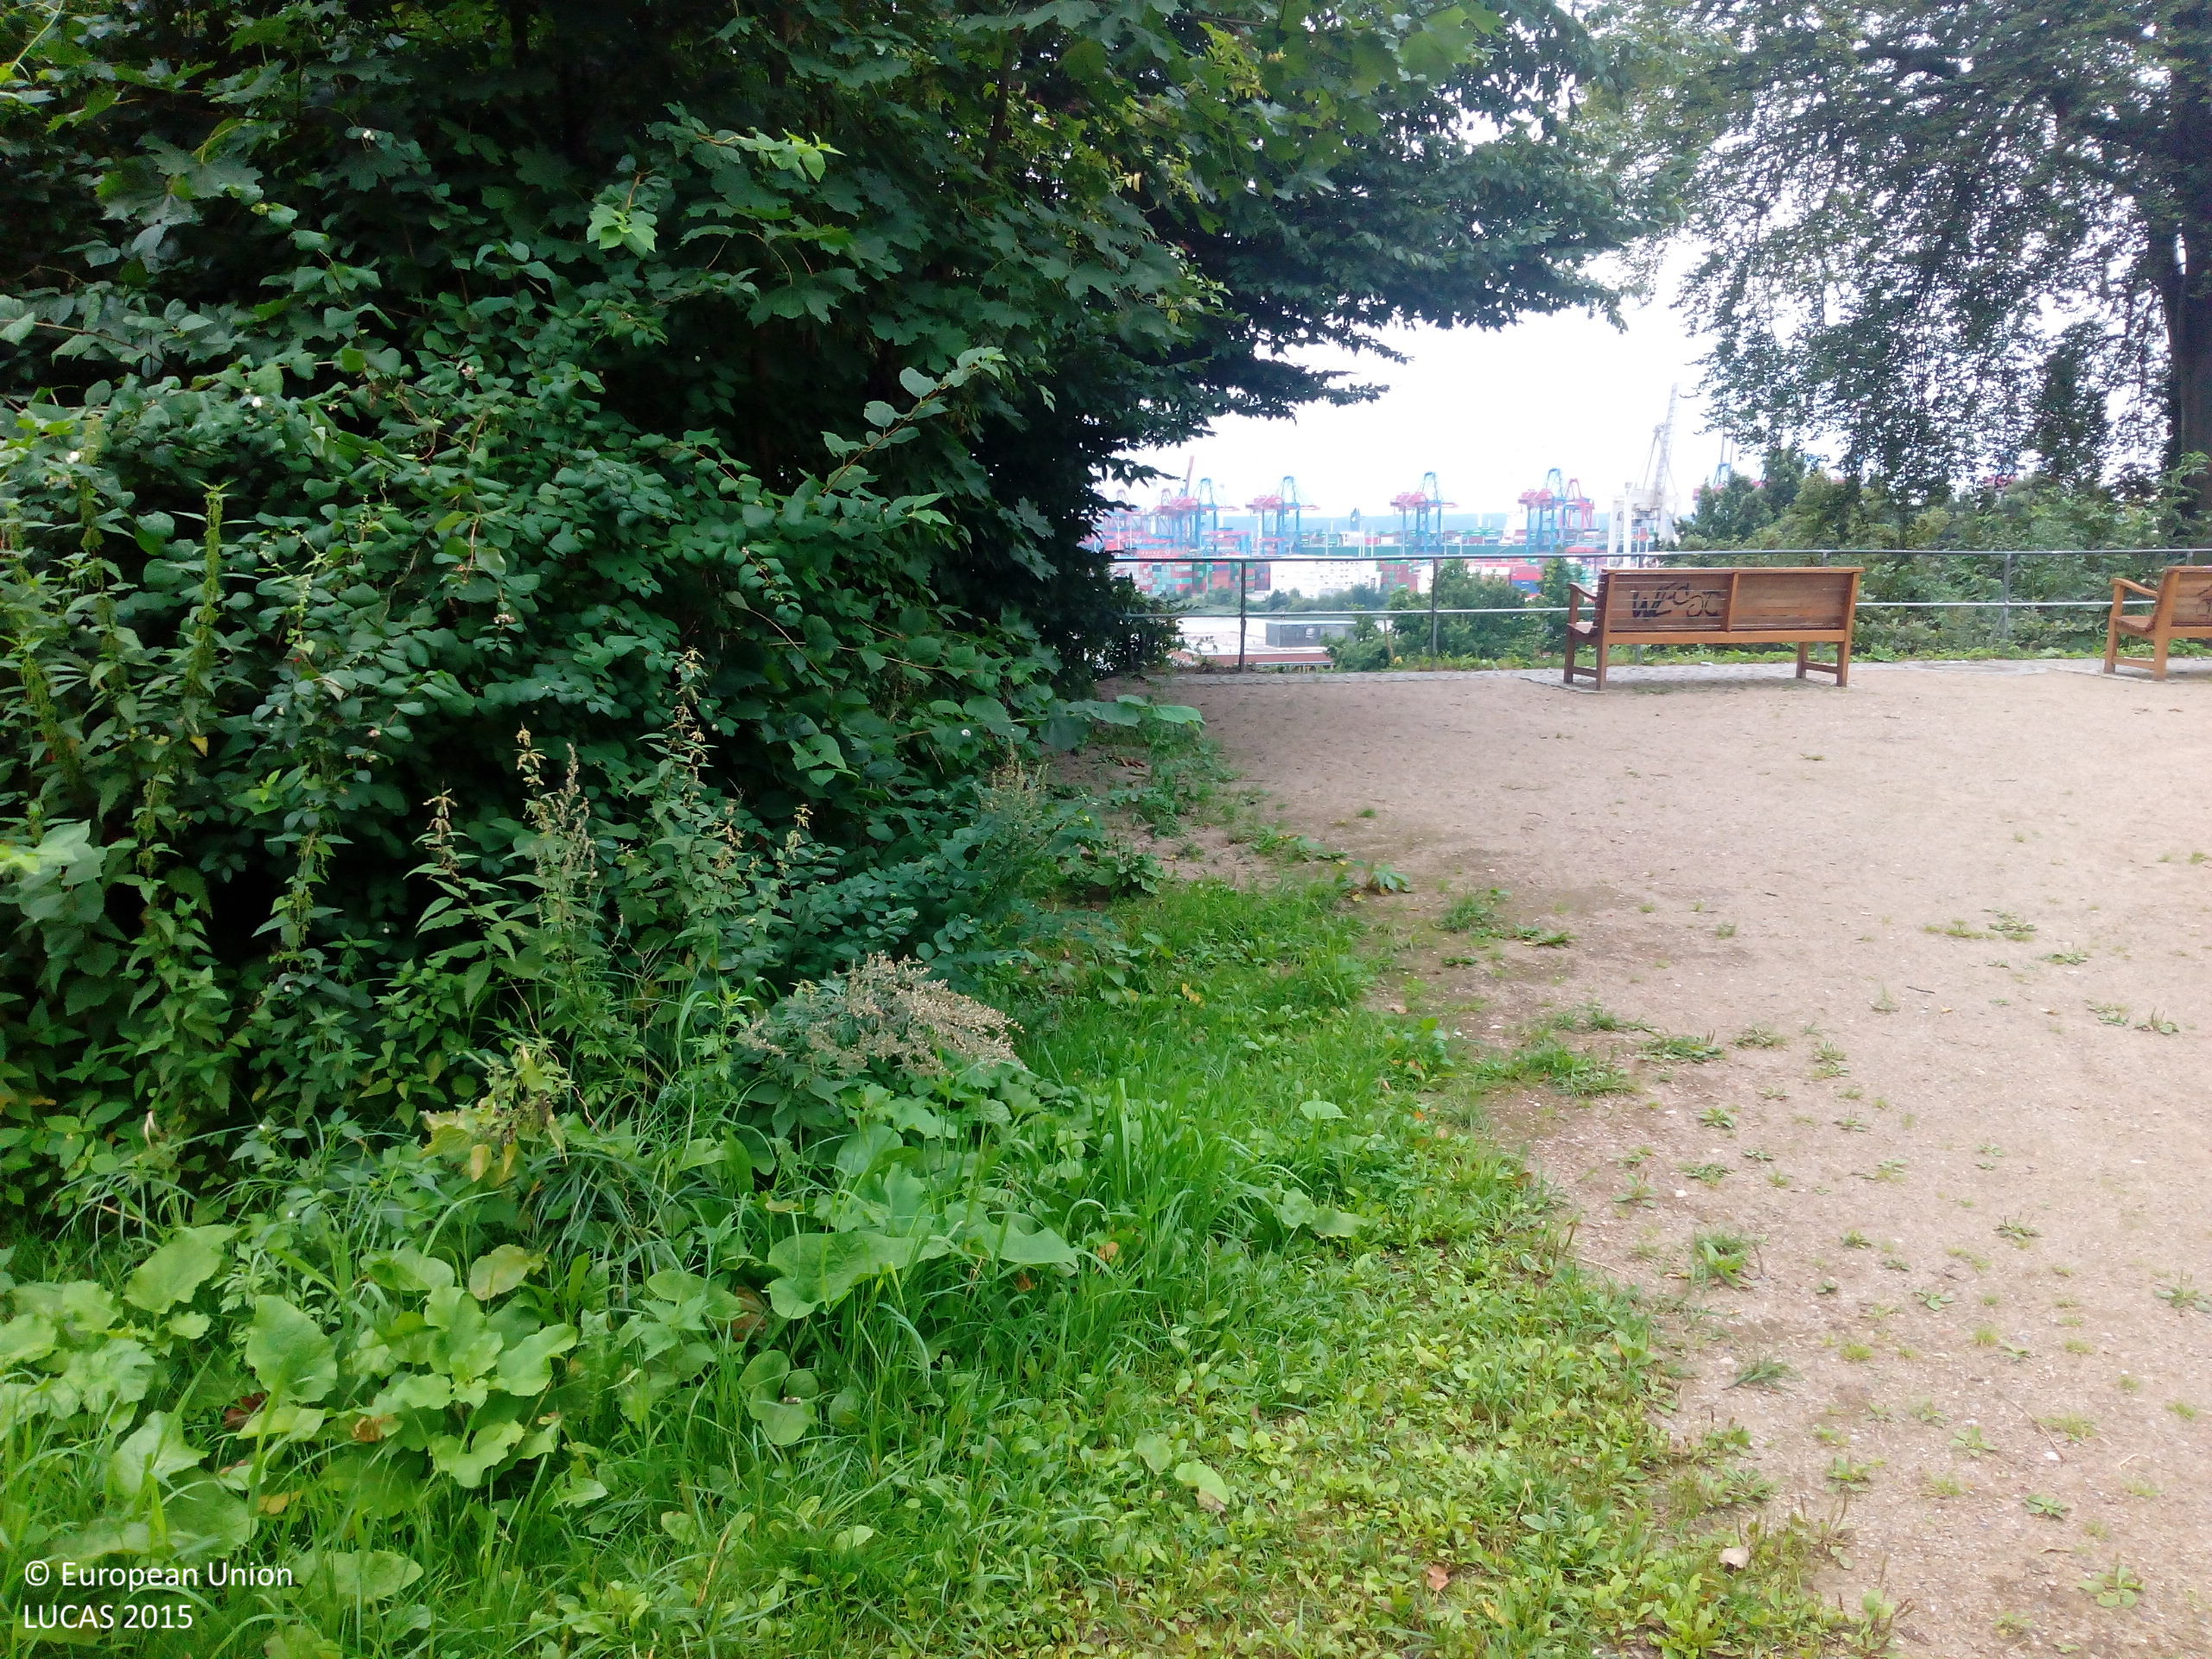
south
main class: Grassland
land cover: Spontaneously vegetated surfaces
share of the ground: > 75 %
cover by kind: herbaceous plants 95 %, shrubs 5 %
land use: Amenities, museums, leisure
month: August
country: DE
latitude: 53.5457
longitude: 9.9246
